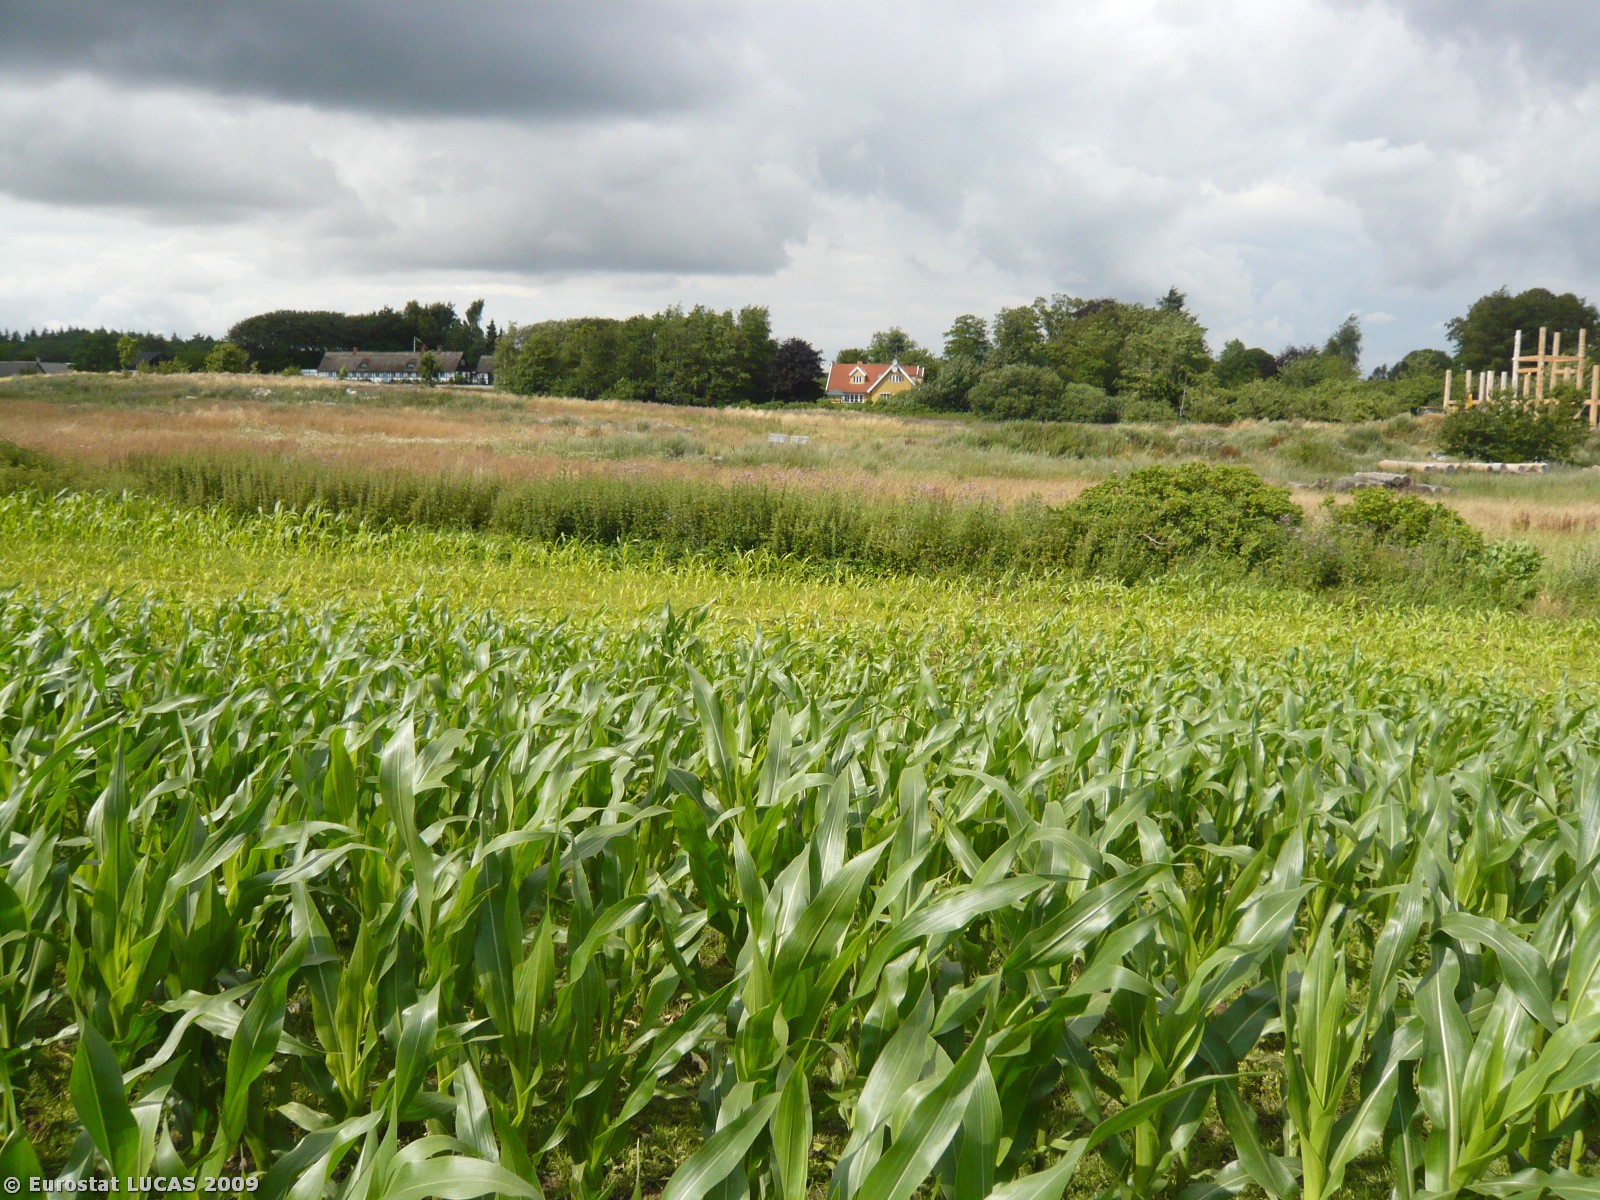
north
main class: Cropland
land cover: Maize
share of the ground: > 75 %
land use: Agriculture (excluding fallow land and kitchen gardens)
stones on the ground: < 10 %
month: July
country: DK
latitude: 55.5267
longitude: 11.8835
